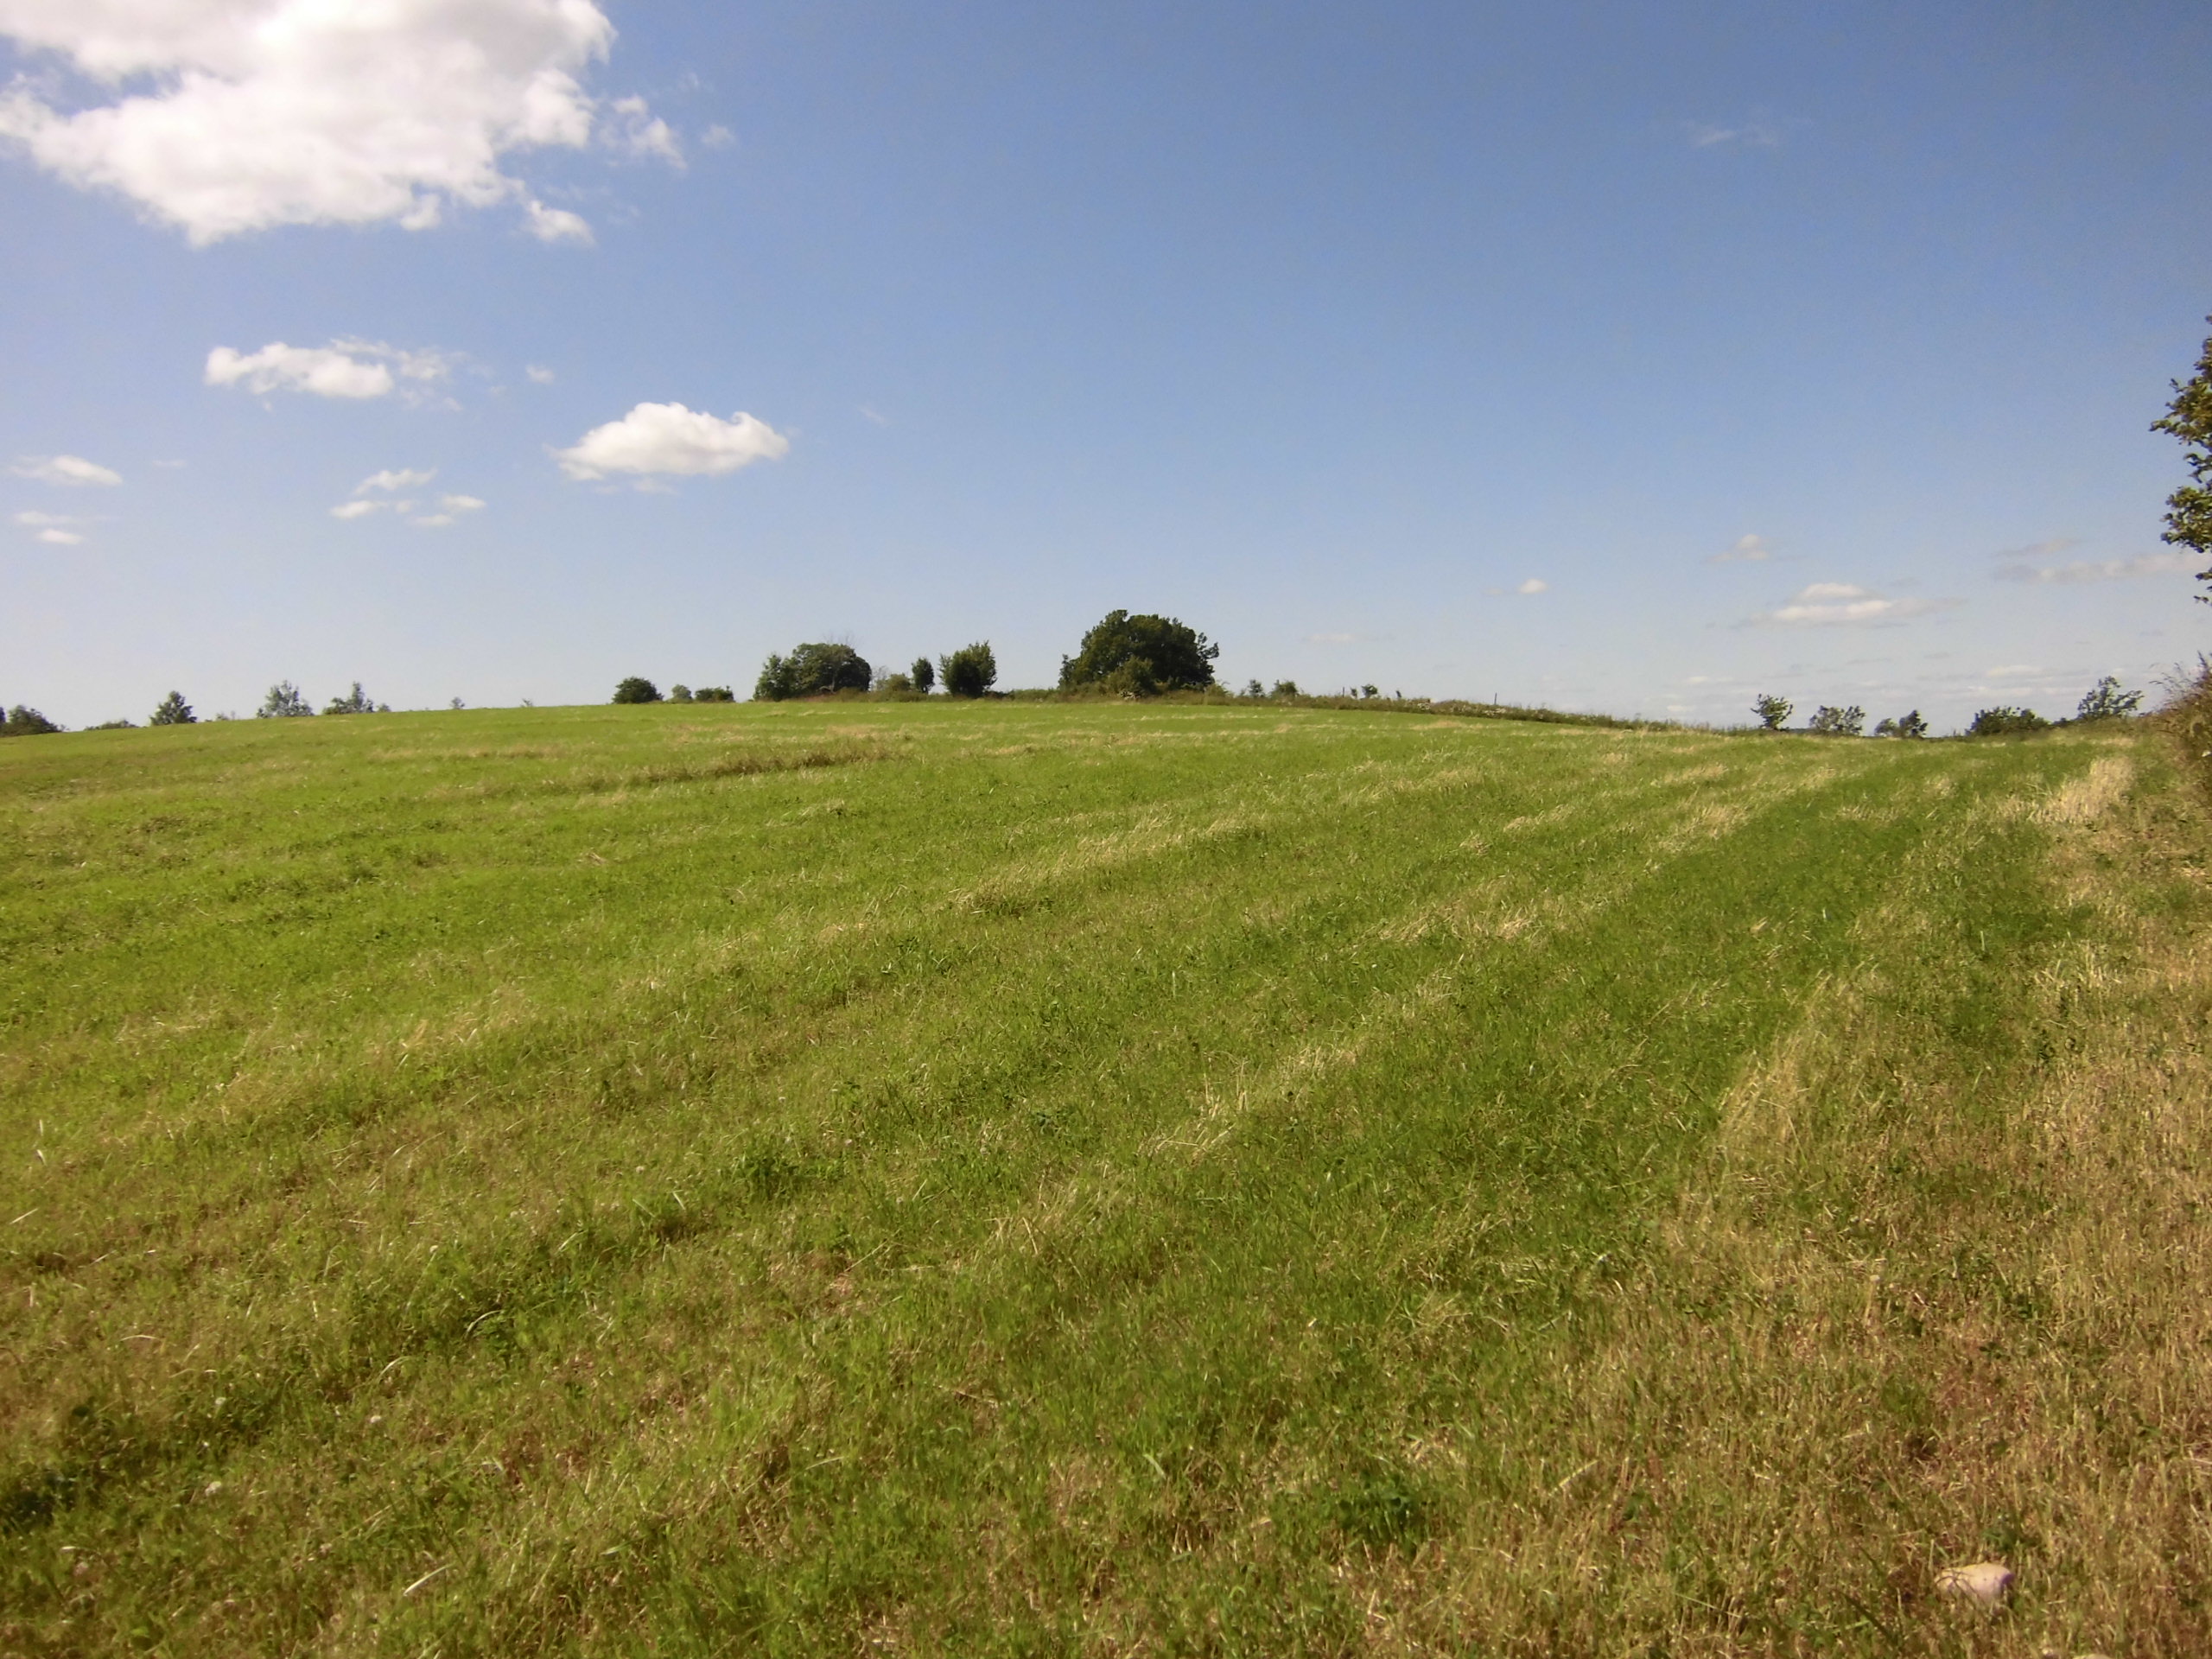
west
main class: Grassland
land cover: Grassland without tree/shrub cover
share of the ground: > 75 %
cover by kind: herbaceous plants 95 %, unconsolidated bare surface 5 %
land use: Agriculture (excluding fallow land and kitchen gardens)
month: July
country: SE
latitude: 57.3606
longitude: 15.2332
